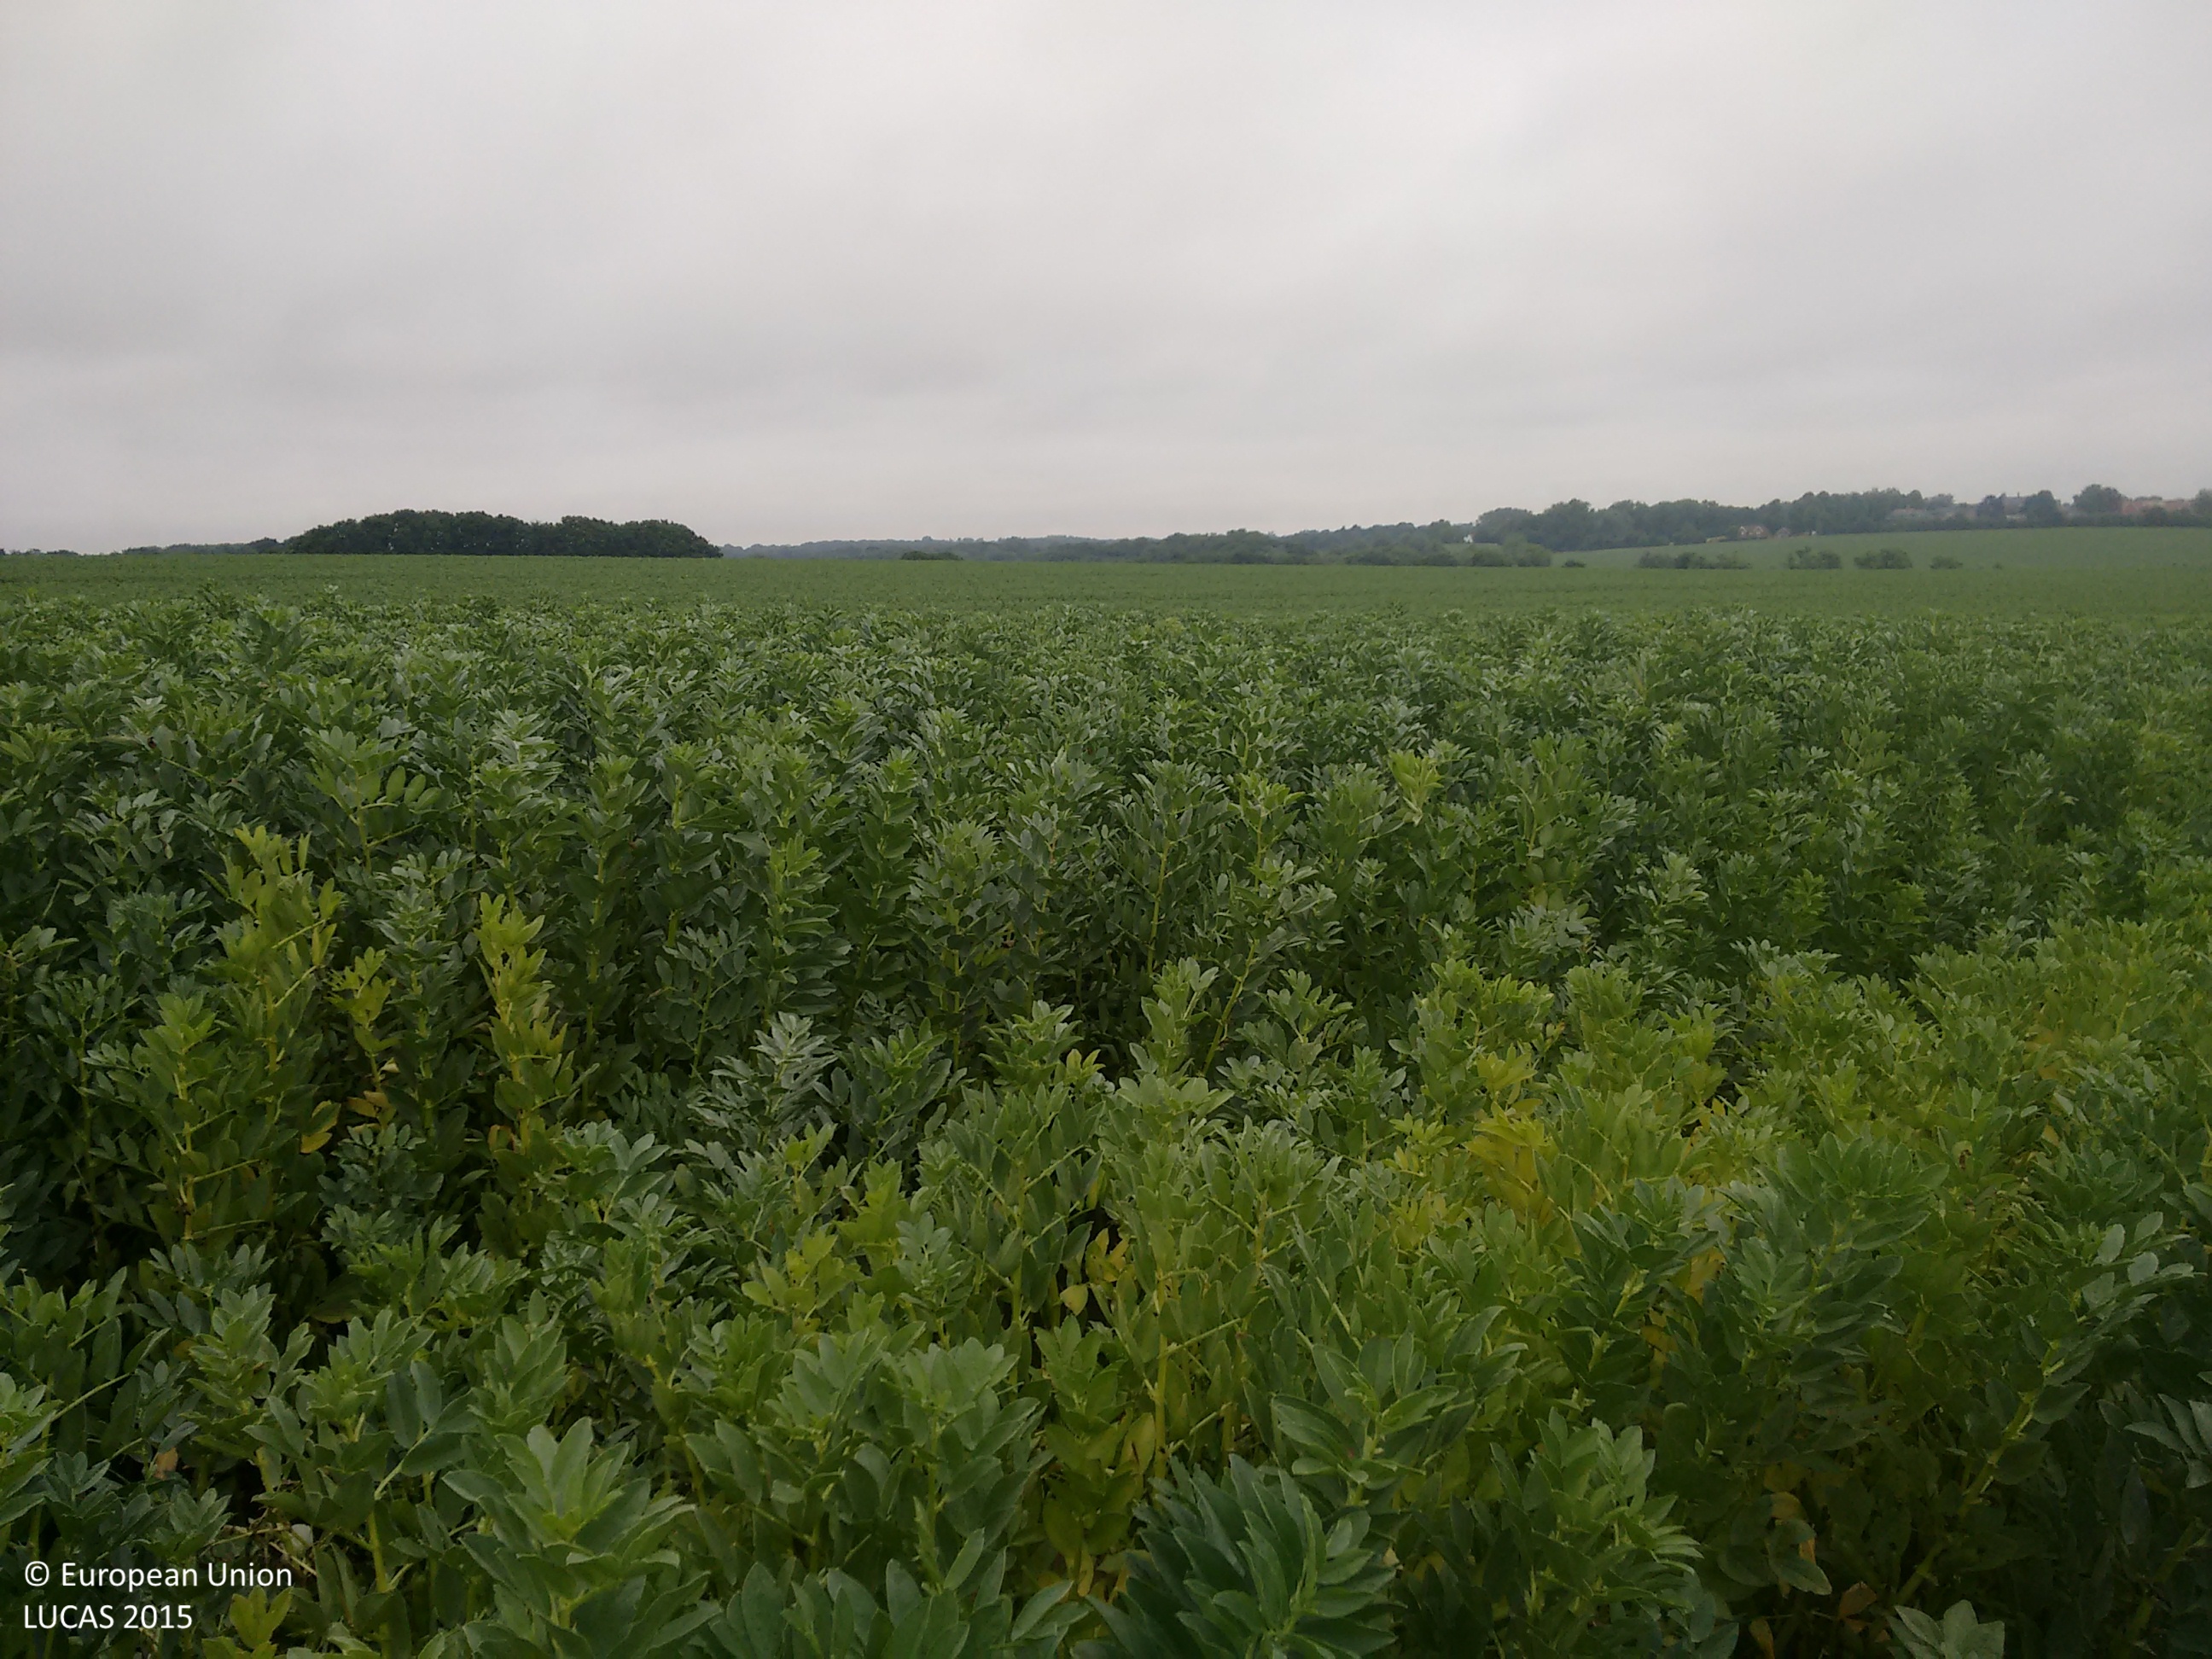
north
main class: Cropland
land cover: Dry pulses
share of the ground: > 75 %
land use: Agriculture (excluding fallow land and kitchen gardens)
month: July
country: GB
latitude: 51.6582
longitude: 0.3577
